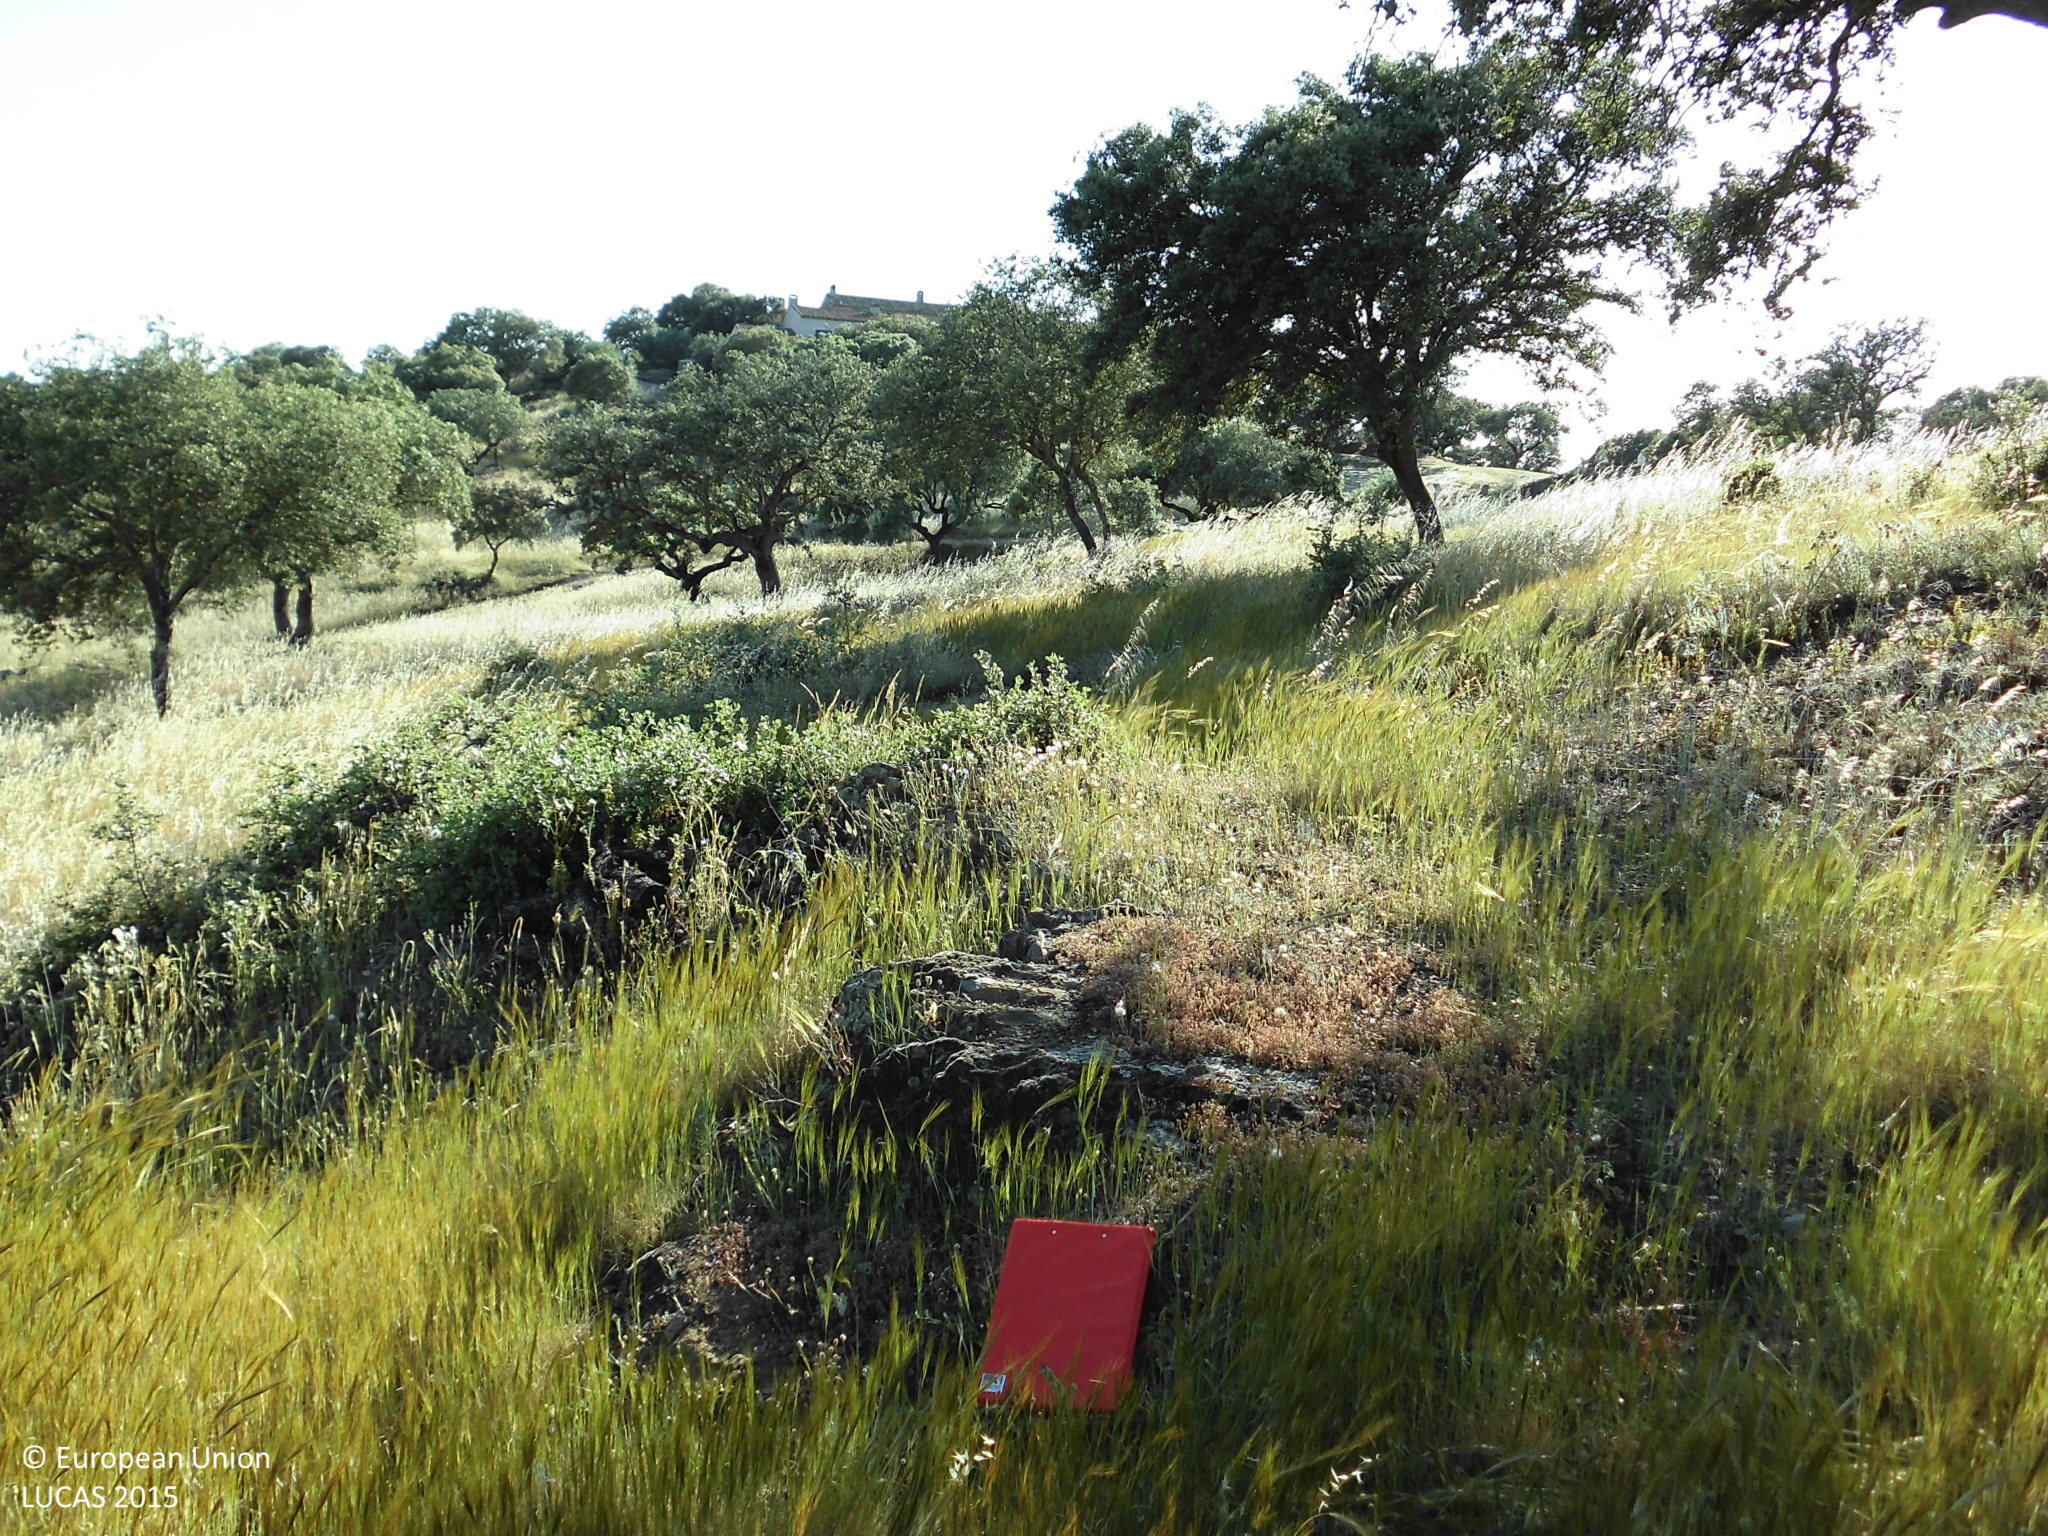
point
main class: Woodland
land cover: Broadleaved woodland
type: broadleaved evergreen forest
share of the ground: 10 - 25 %
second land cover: Grassland without tree/shrub cover
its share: > 75 %
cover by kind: herbaceous plants 70 %, broadleaved forest trees 25 %, shrubs 5 %
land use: Forestry
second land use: Agriculture (excluding fallow land and kitchen gardens)
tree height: > 5 m
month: May
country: ES
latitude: 39.4986
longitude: -6.0989
